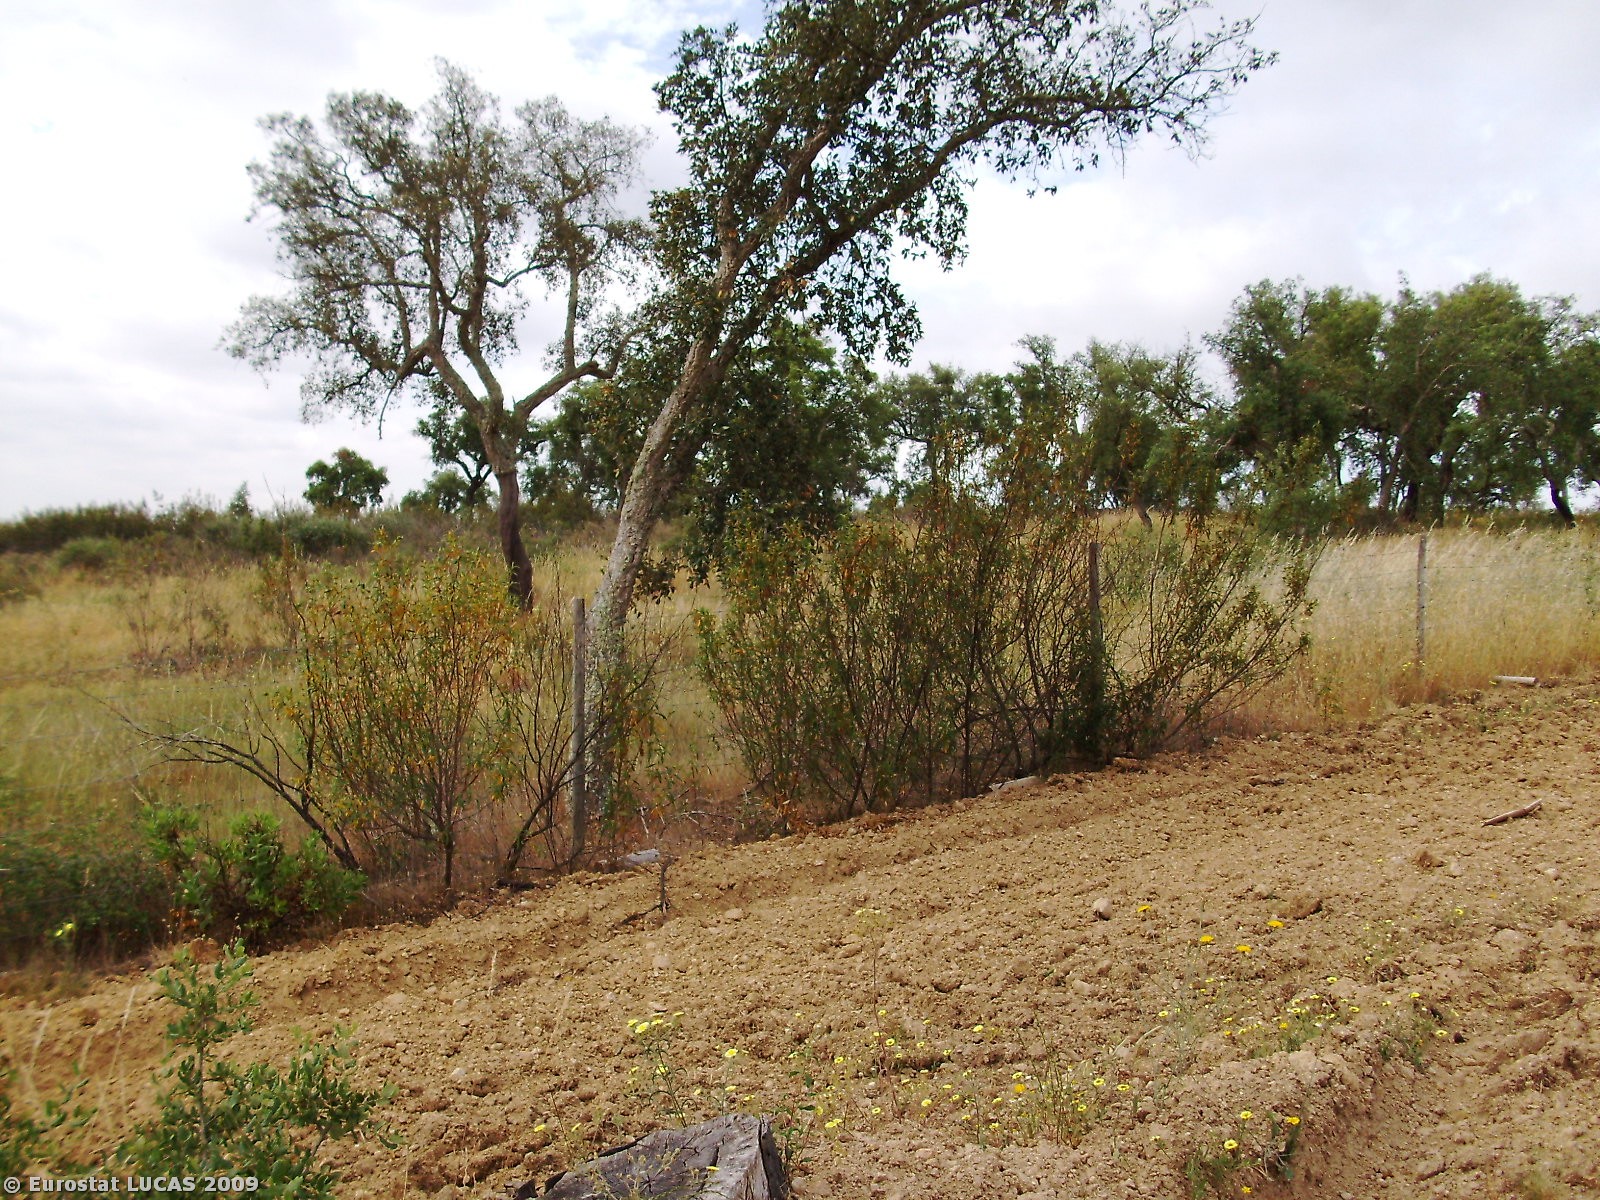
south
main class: Woodland
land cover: Broadleaved woodland
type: broadleaved evergreen forest
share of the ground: 50 - 75 %
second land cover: Spontaneously vegetated surfaces
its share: 25 - 50 %
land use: Forestry
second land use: Fallow land
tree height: > 5 m
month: May
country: PT
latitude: 39.0058
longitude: -7.9357
